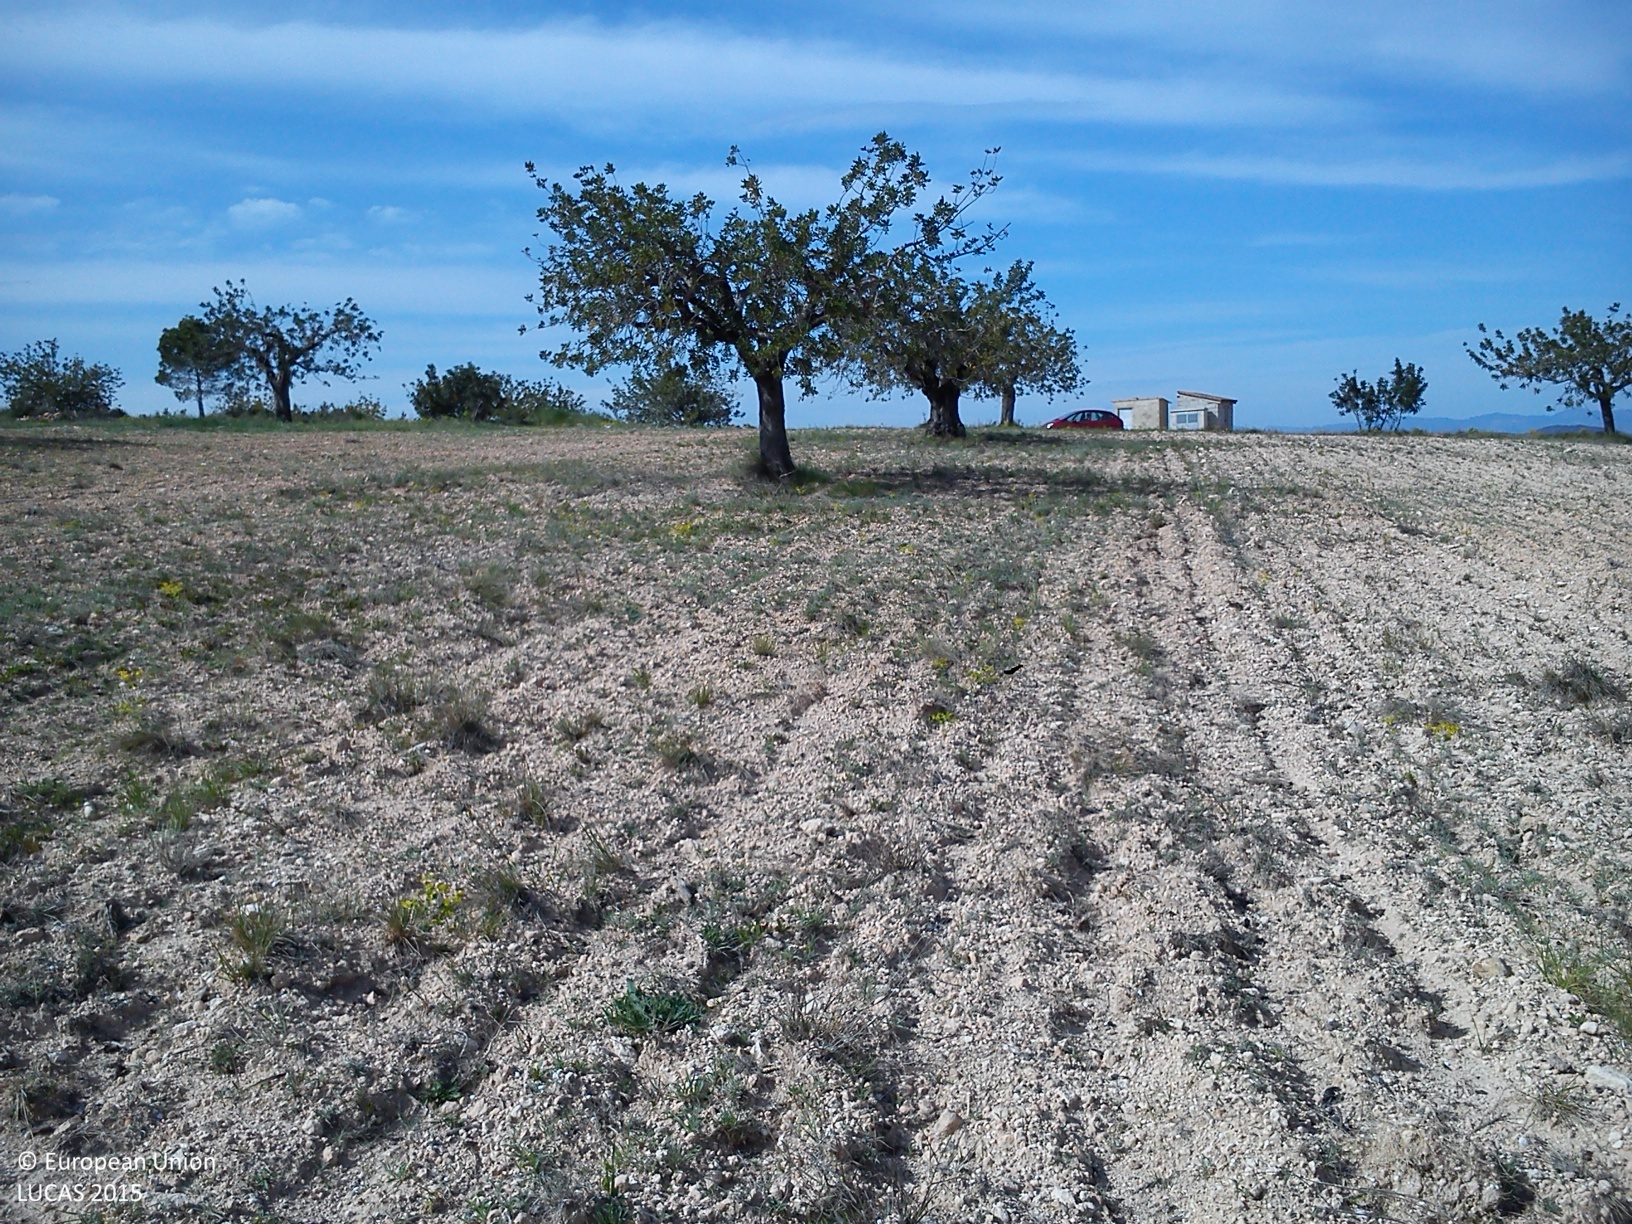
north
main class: Cropland
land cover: Permanent industrial crops
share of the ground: < 10 %
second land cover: Spontaneously vegetated surfaces
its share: 25 - 50 %
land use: Agriculture (excluding fallow land and kitchen gardens)
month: April
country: ES
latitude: 39.4483
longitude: -0.6542
